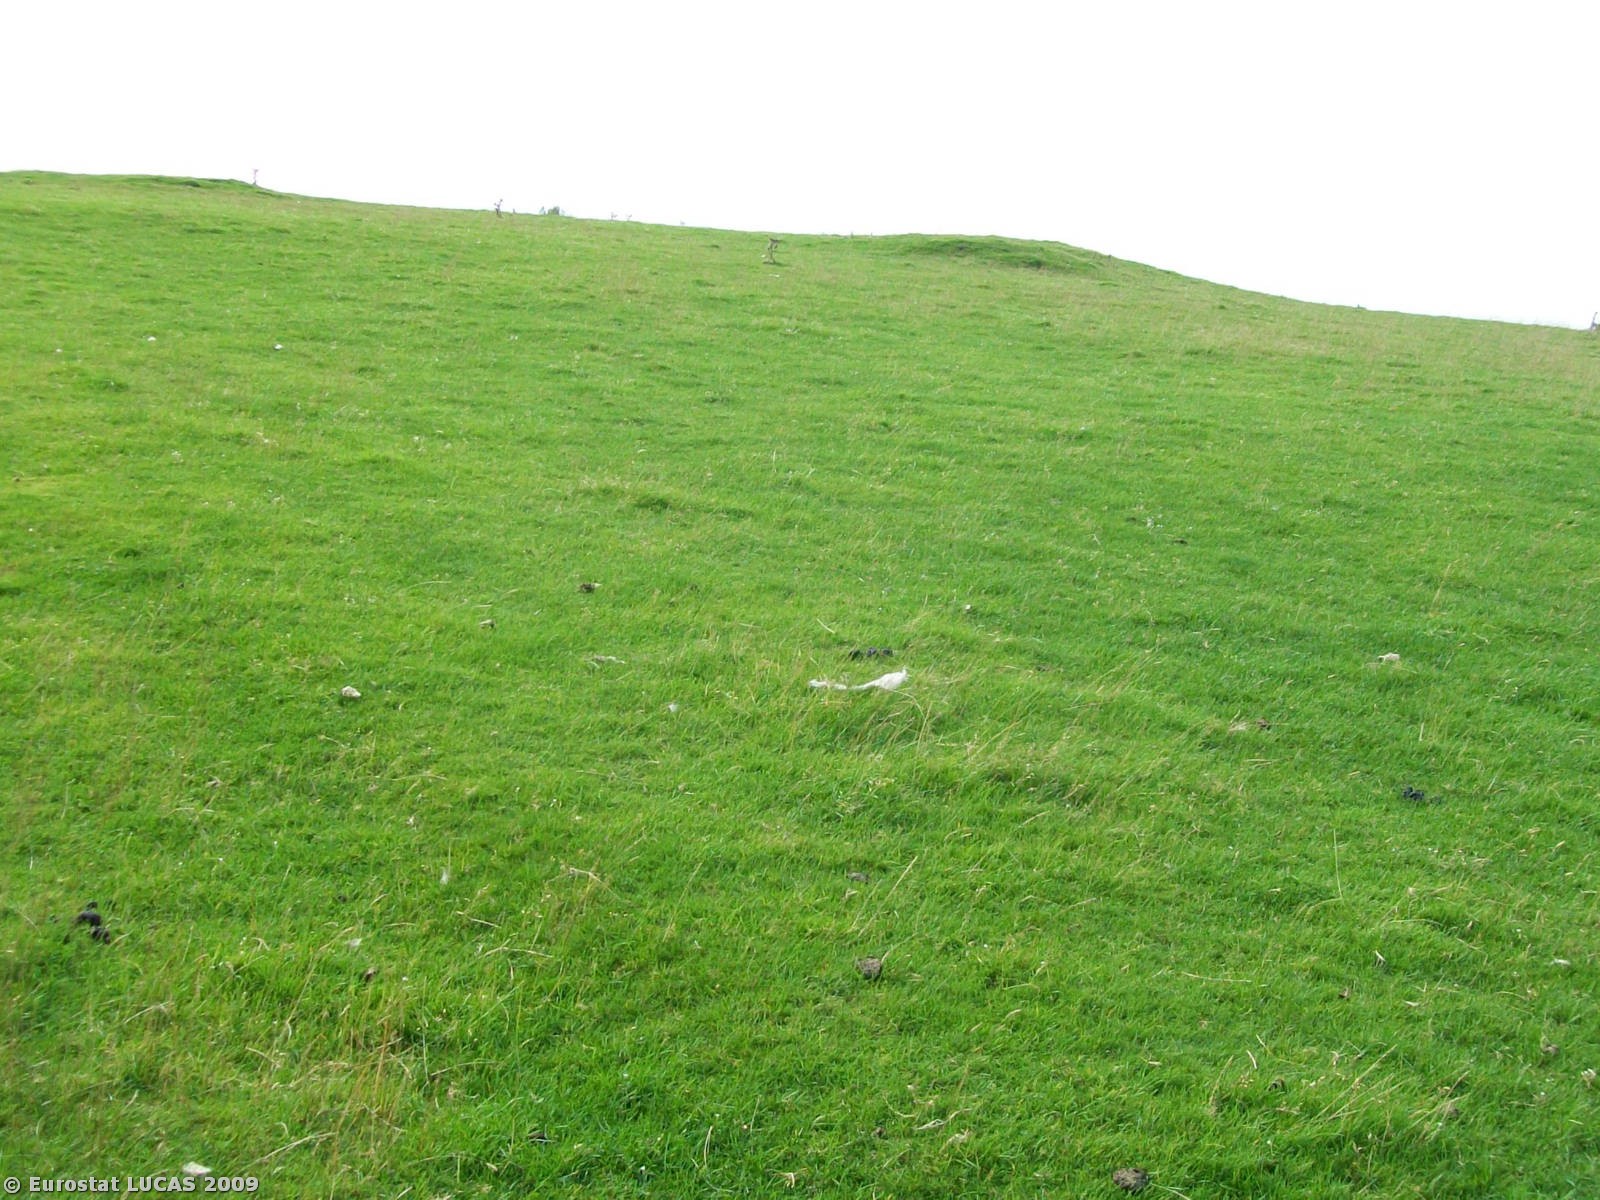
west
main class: Grassland
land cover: Grassland without tree/shrub cover
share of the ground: < 10 %
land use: Agriculture (excluding fallow land and kitchen gardens)
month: August
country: GB
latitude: 54.8932
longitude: -4.7163
